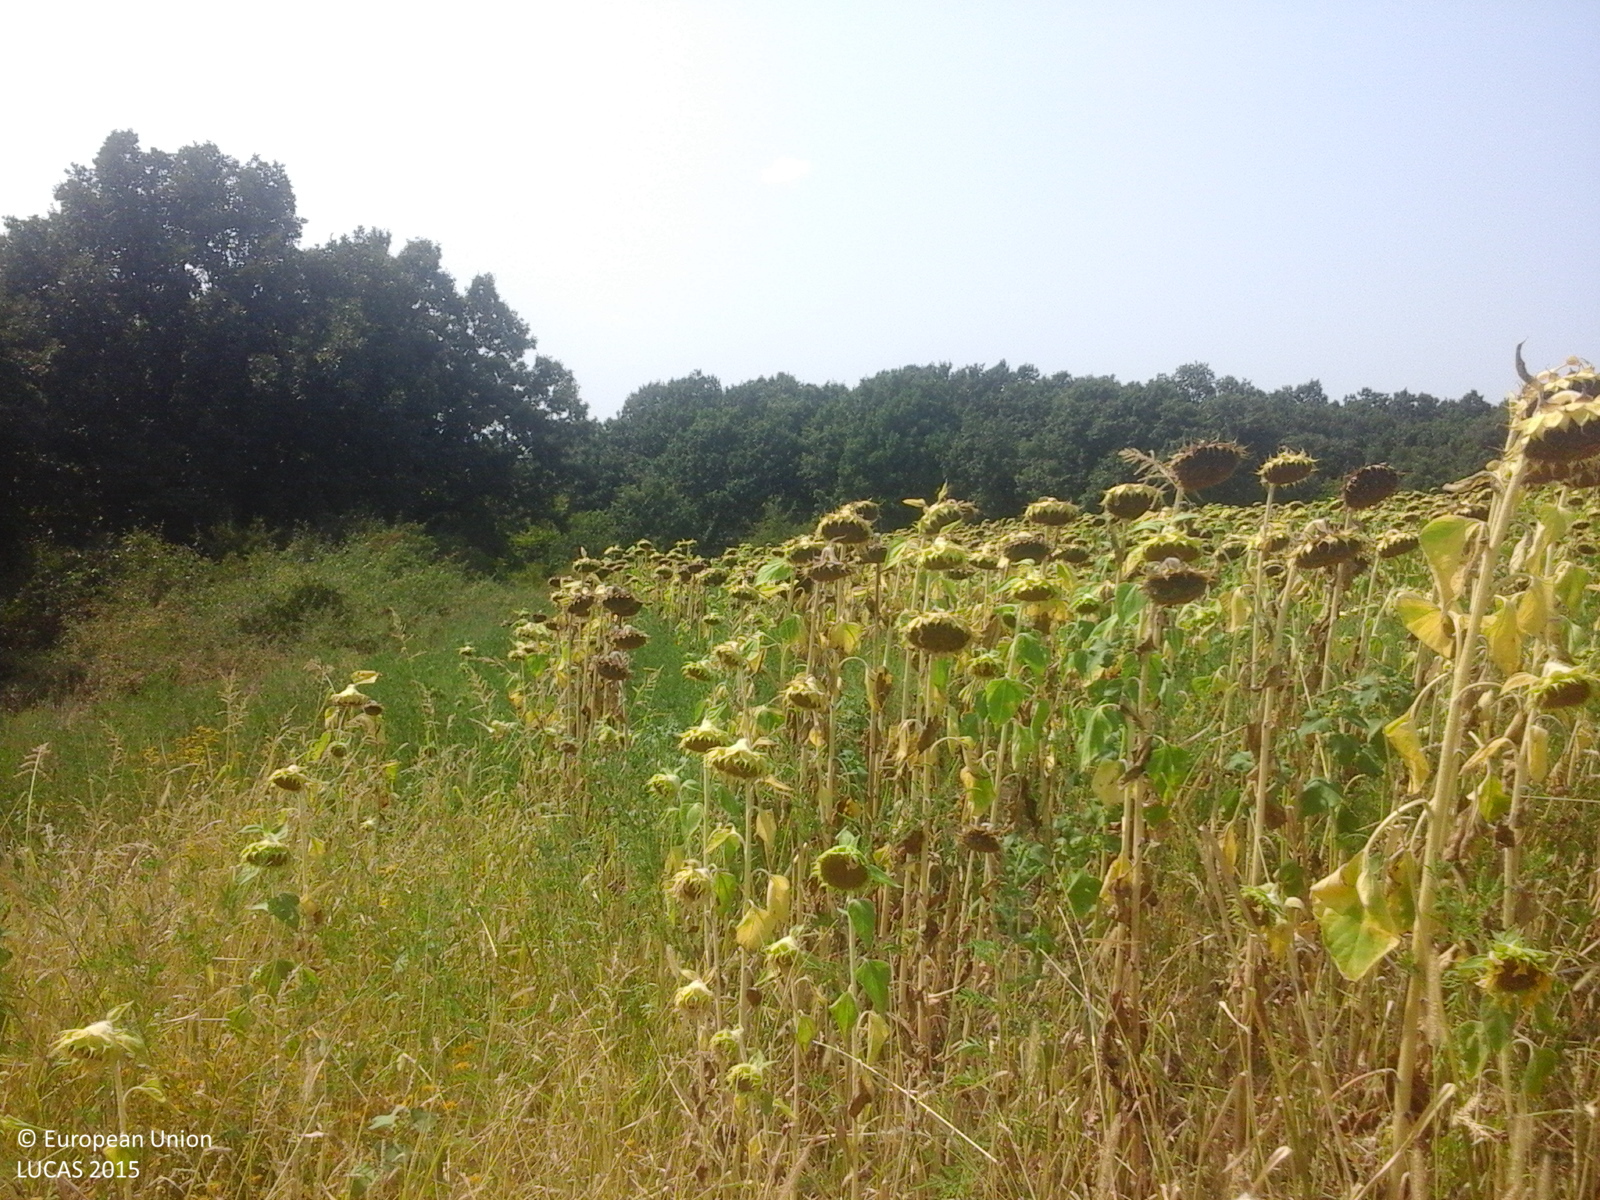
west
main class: Cropland
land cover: Sunflower
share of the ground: > 75 %
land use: Agriculture (excluding fallow land and kitchen gardens)
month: August
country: RO
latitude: 44.2179
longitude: 23.7357
